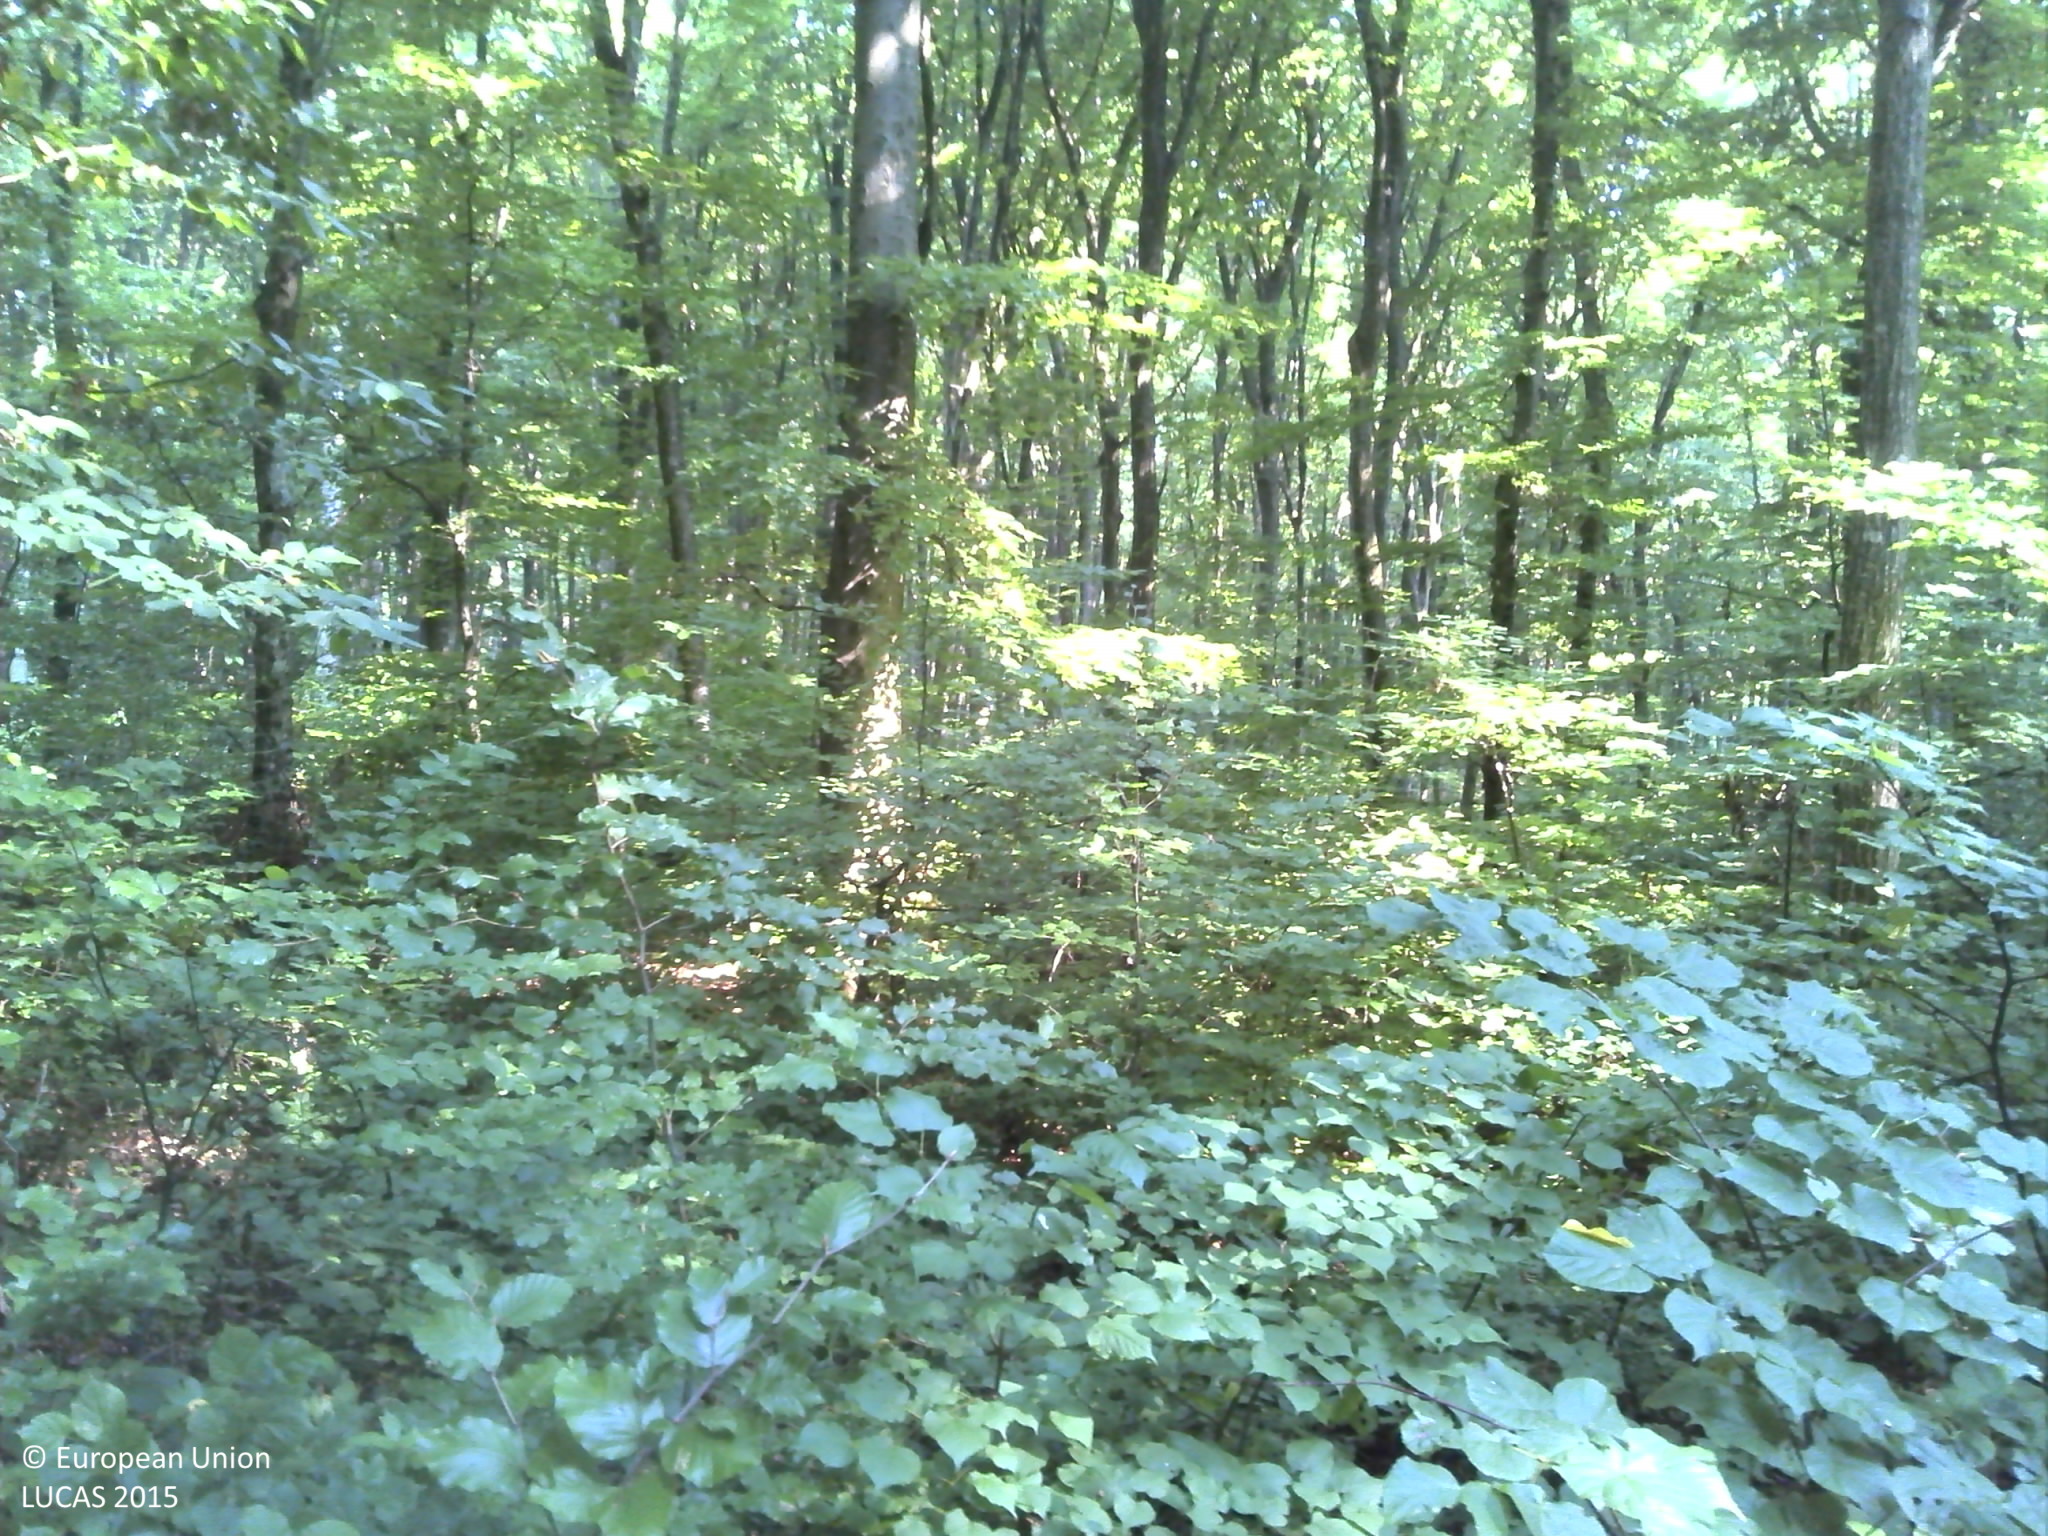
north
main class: Woodland
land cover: Broadleaved woodland
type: acidophilous oak and oak-birch forest
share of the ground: > 75 %
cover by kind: broadleaved forest trees 90 %, shrubs 5 %, herbaceous plants 5 %
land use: Forestry
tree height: > 5 m
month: July
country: HR
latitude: 45.9752
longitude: 16.7506
